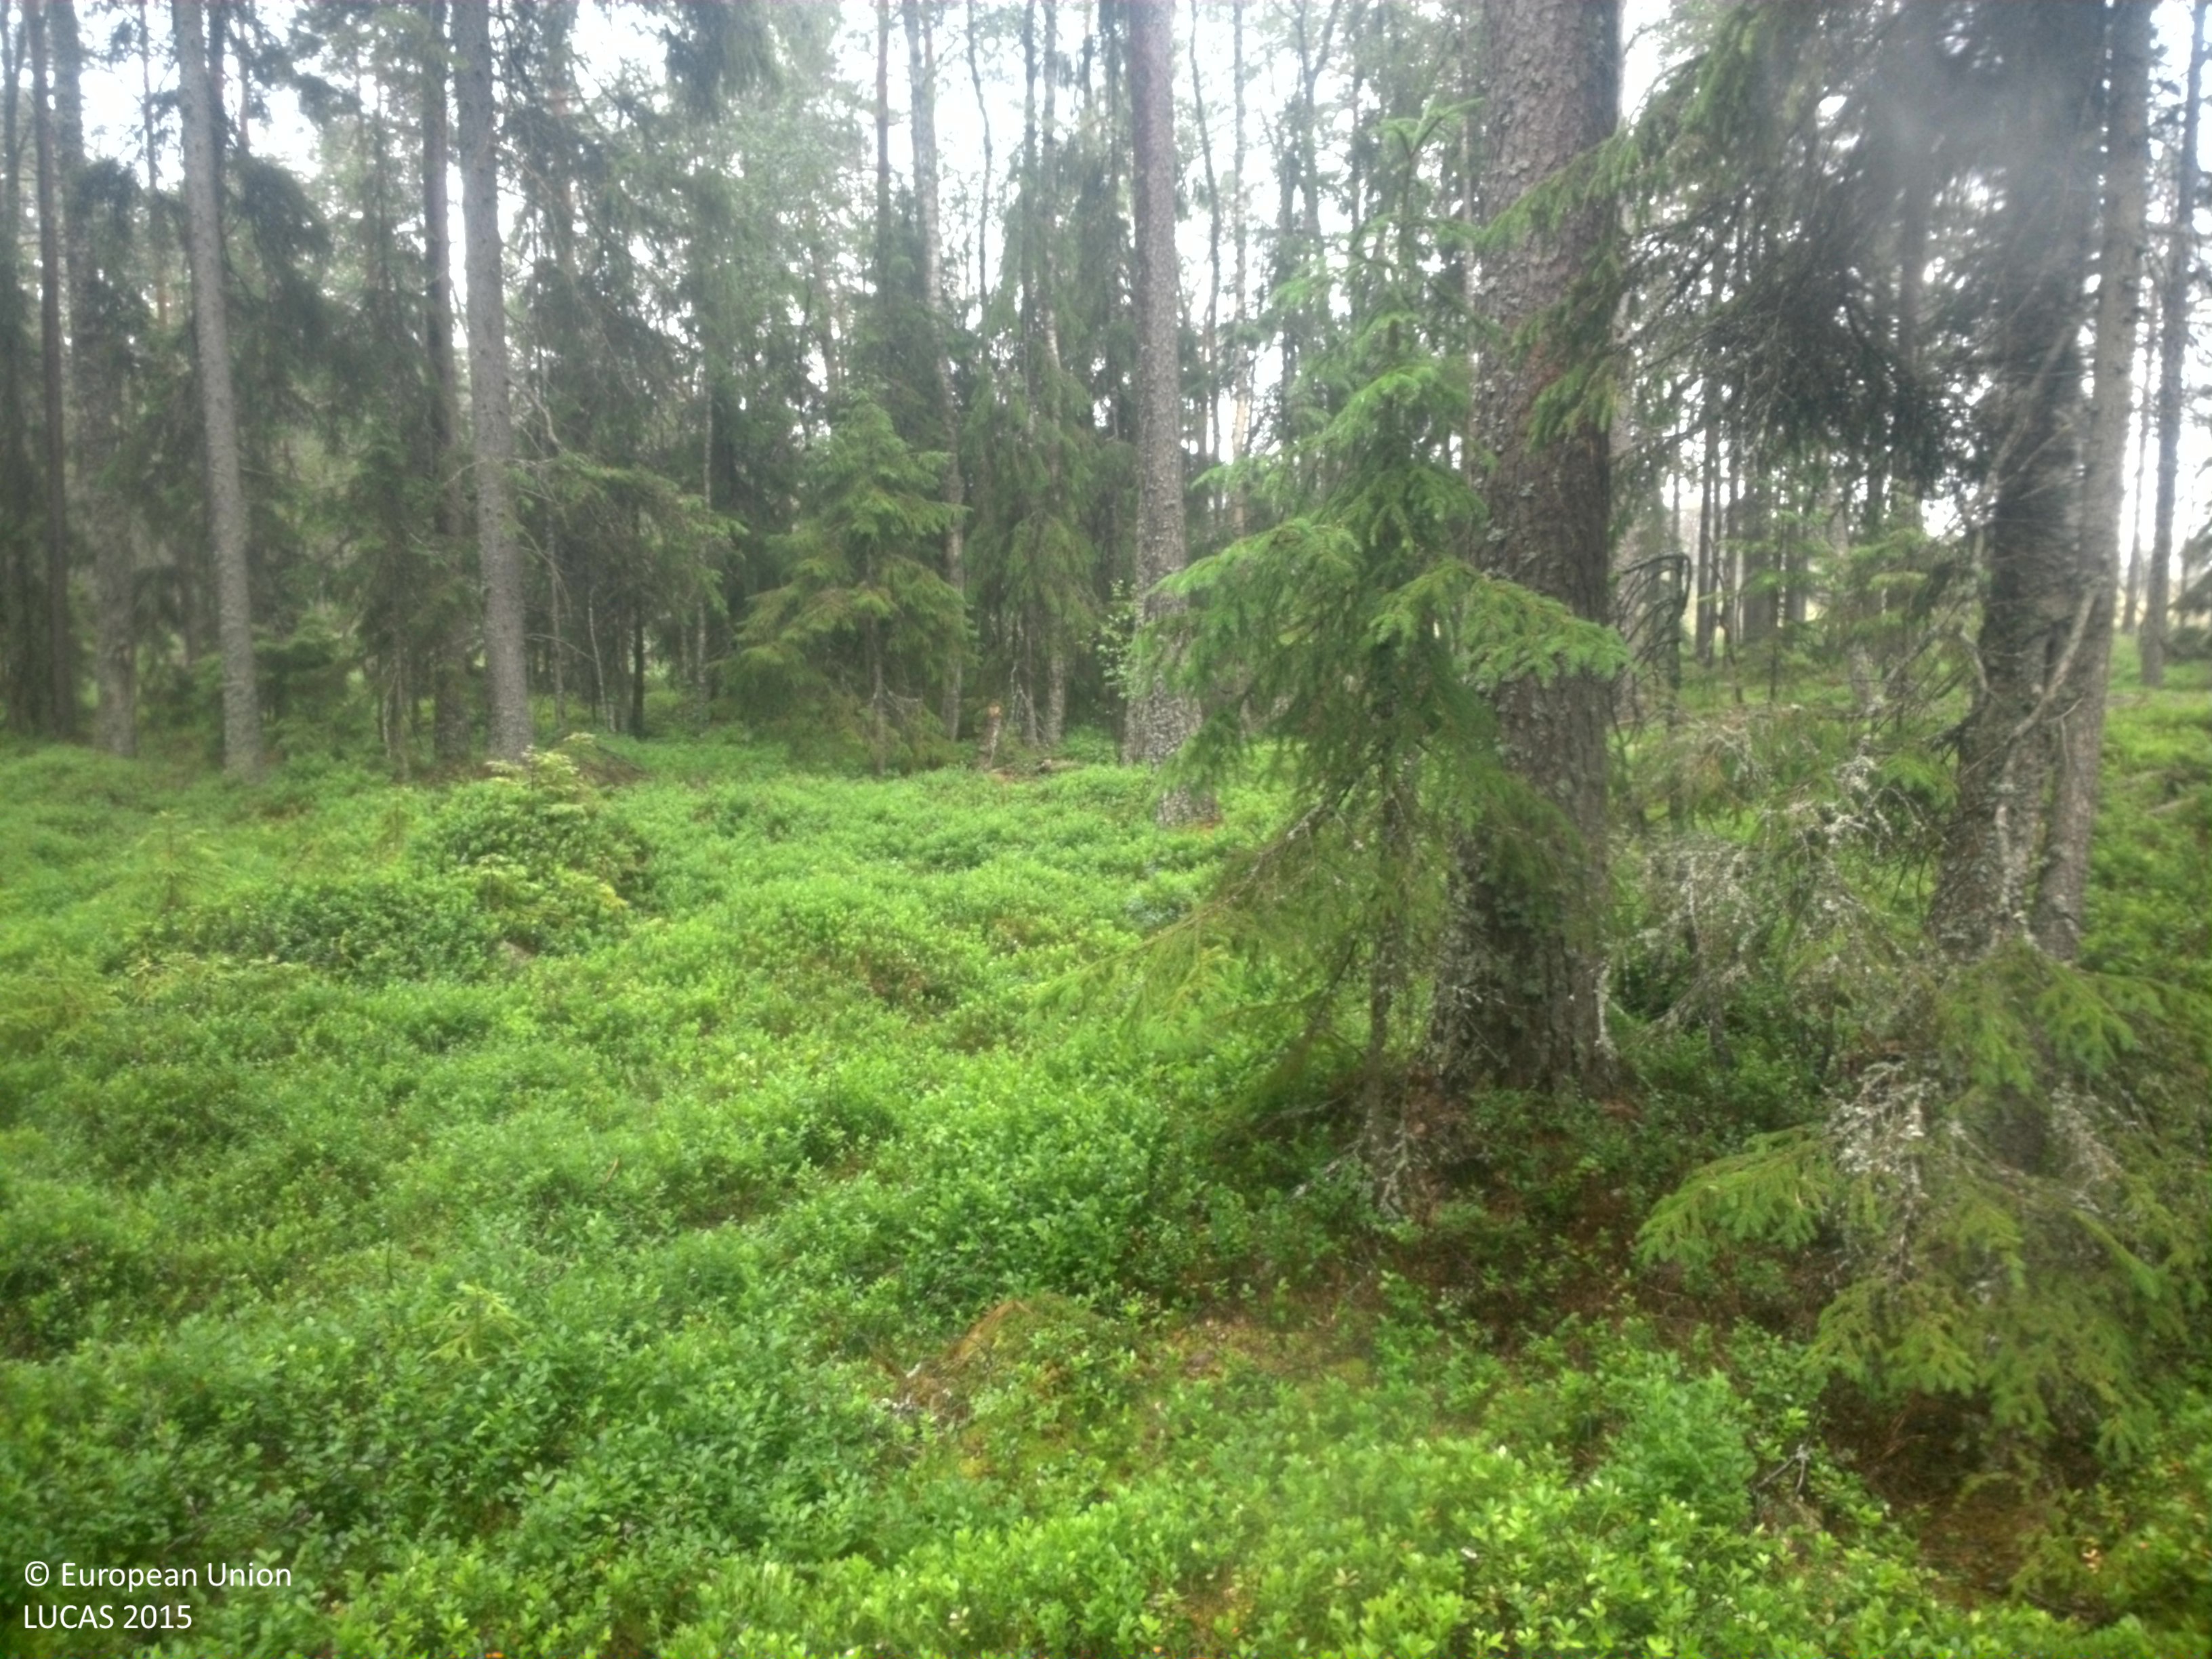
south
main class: Woodland
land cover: Other mixed woodland
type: boreal forest
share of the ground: 50 - 75 %
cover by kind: shrubs 40 %, coniferous forest trees 30 %, broadleaved forest trees 20 %, herbaceous plants 10 %
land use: Forestry
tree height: > 5 m
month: July
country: SE
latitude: 59.3814
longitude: 14.6911
